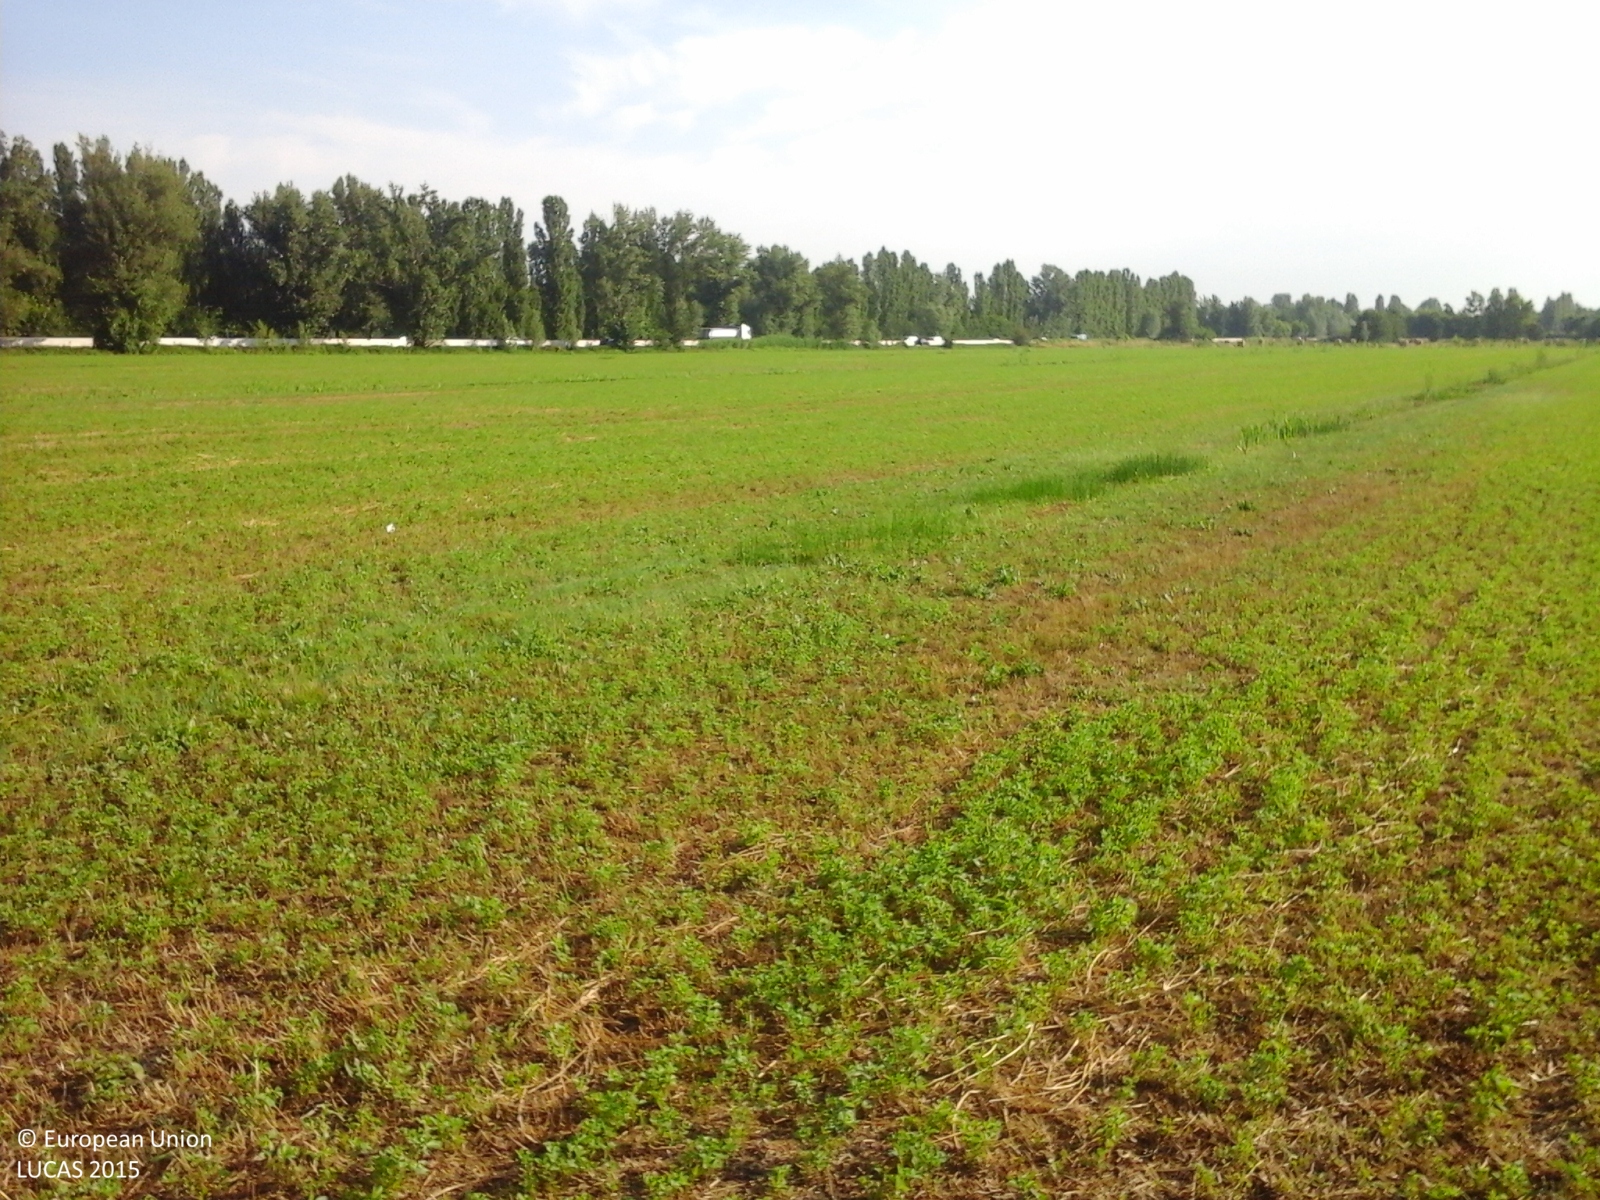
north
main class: Cropland
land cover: Lucerne
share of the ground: > 75 %
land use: Agriculture (excluding fallow land and kitchen gardens)
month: June
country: IT
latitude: 44.6168
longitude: 10.9431
